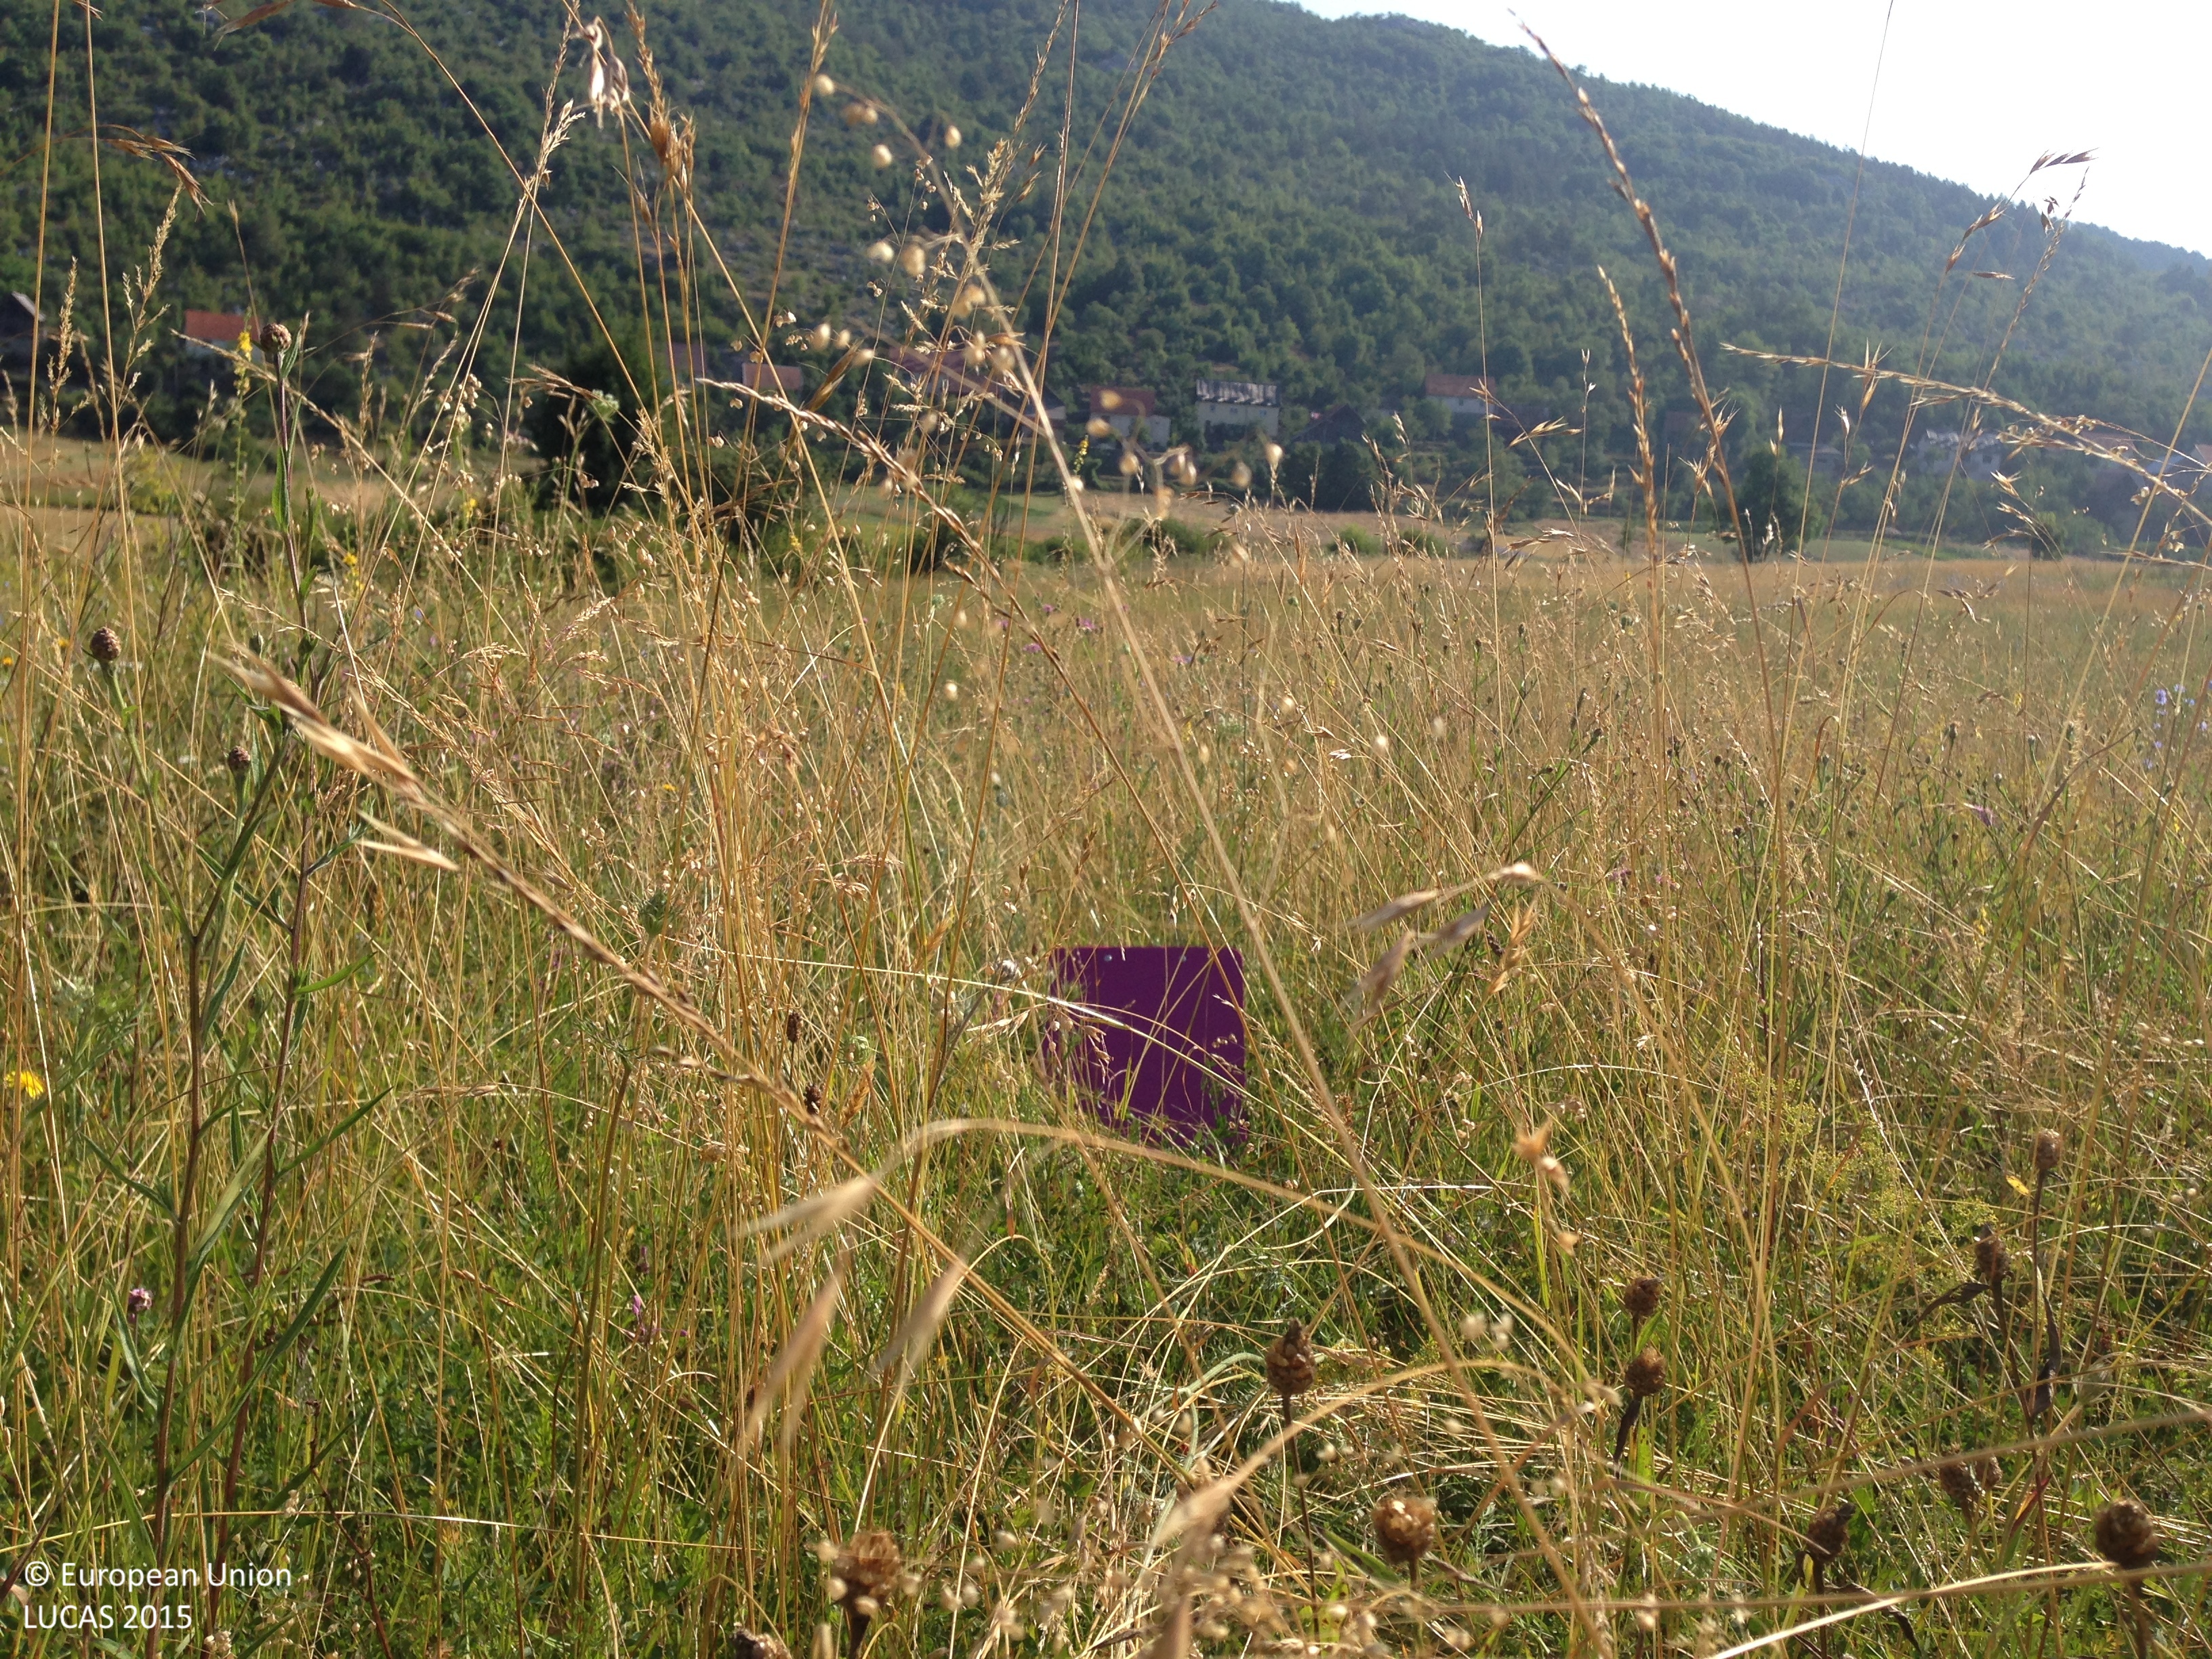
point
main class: Grassland
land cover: Grassland without tree/shrub cover
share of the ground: > 75 %
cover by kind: herbaceous plants 95 %, shrubs 5 %
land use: Agriculture (excluding fallow land and kitchen gardens)
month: July
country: HR
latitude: 44.7604
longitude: 15.2367
